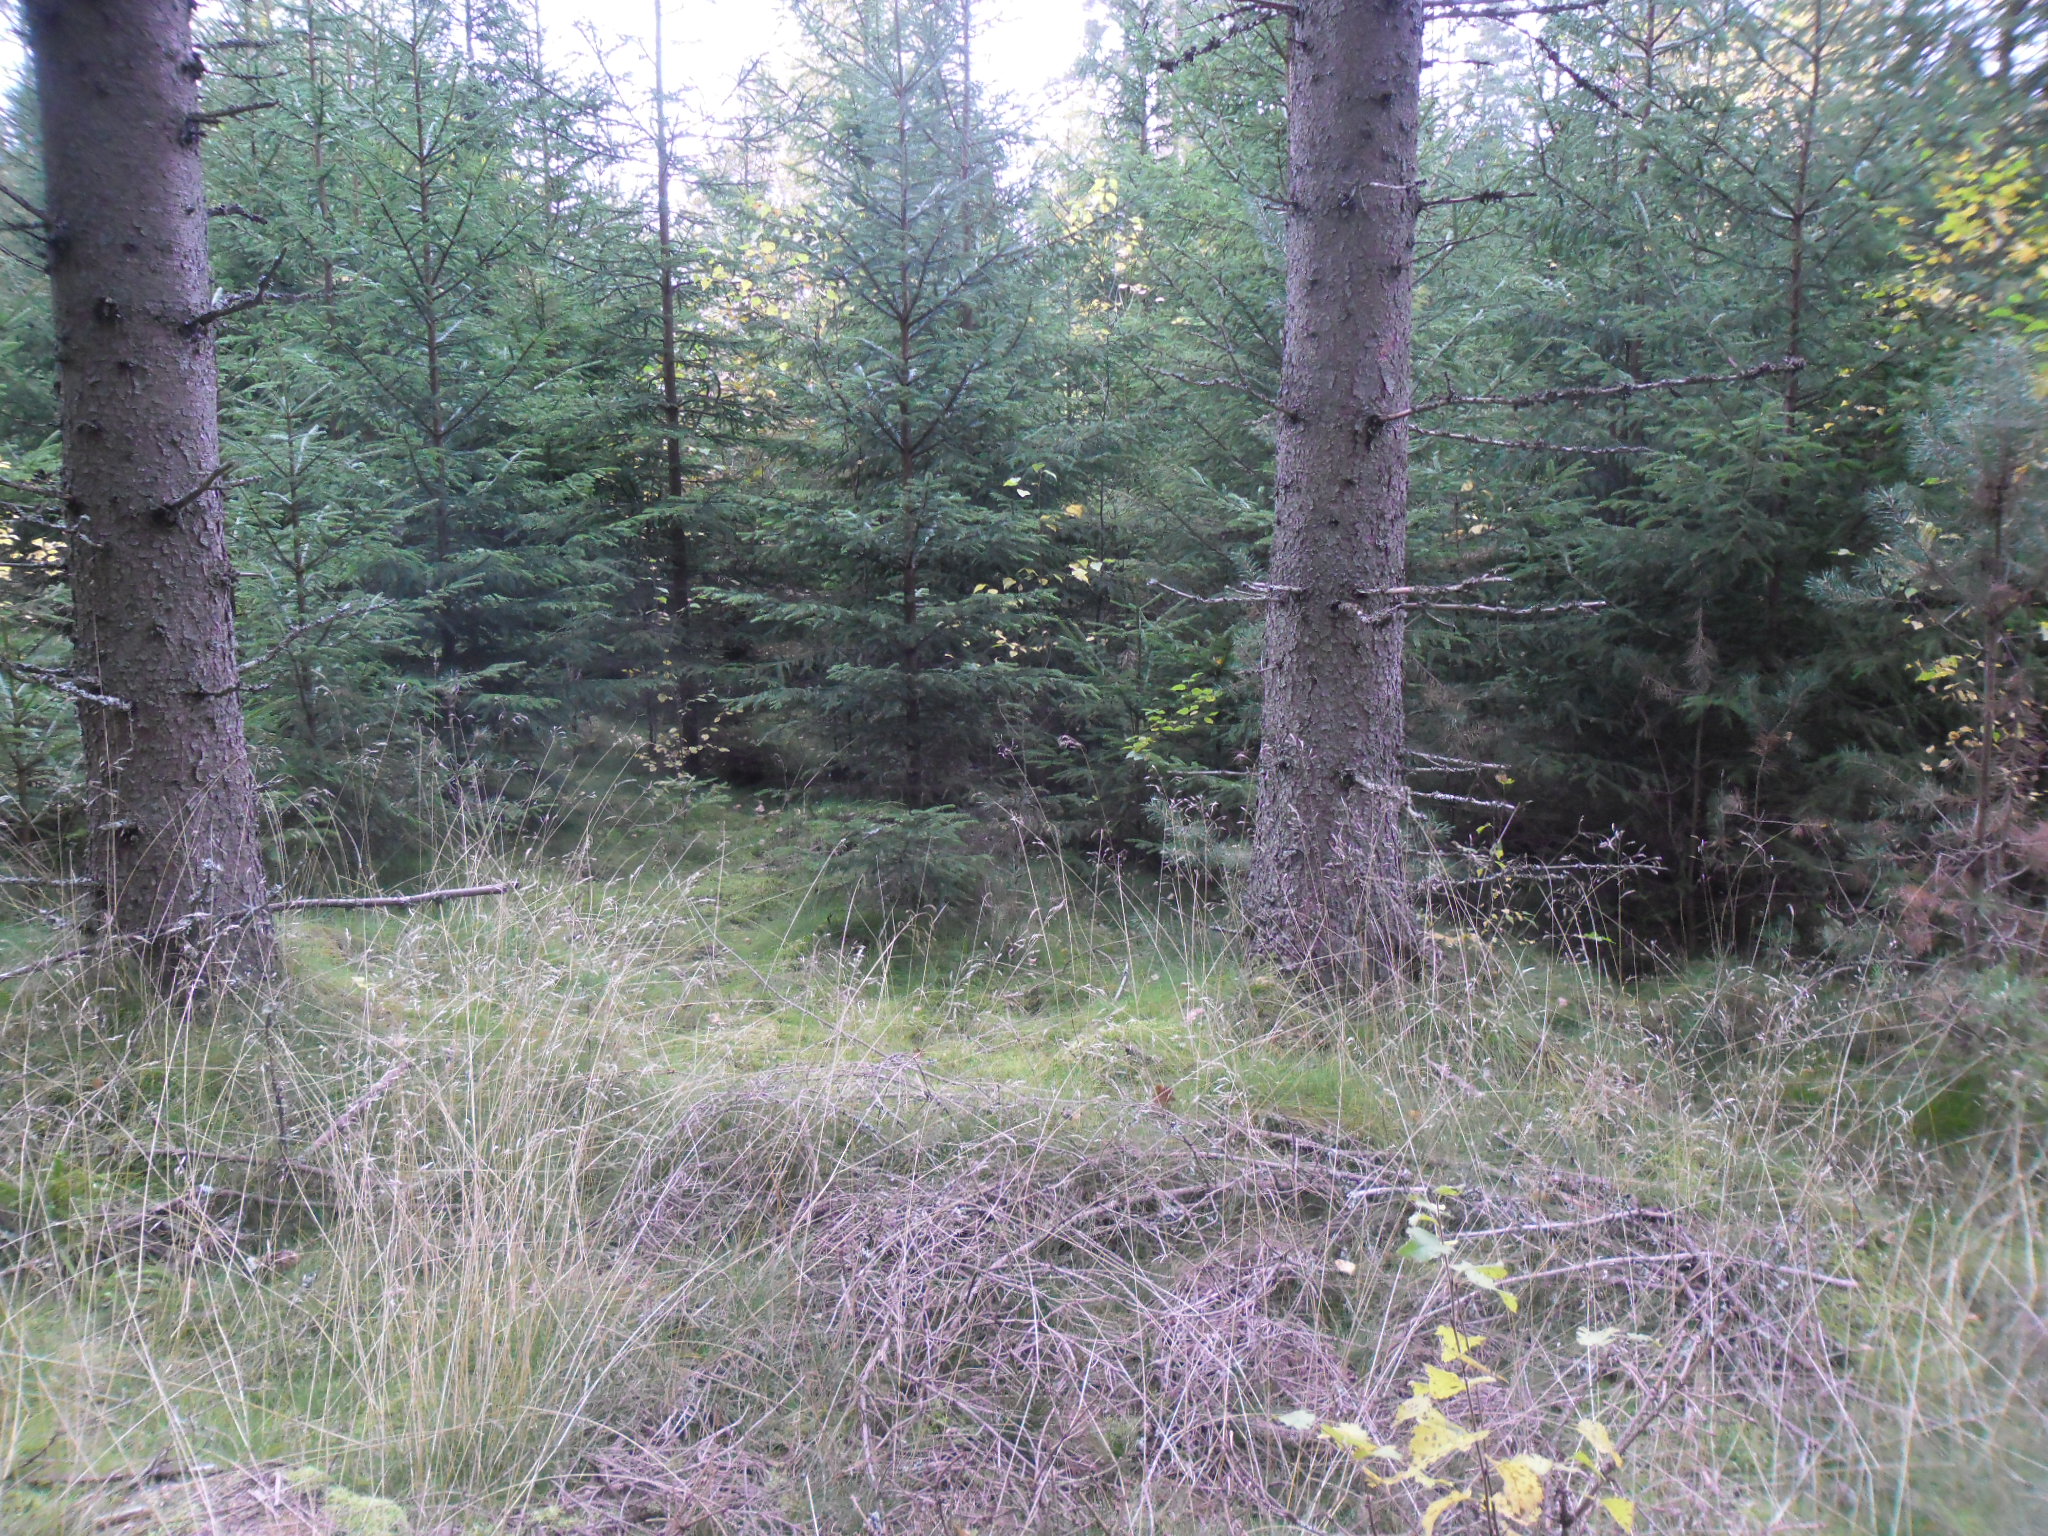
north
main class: Woodland
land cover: Spruce dominated coniferous woodland
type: boreal forest
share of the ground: > 75 %
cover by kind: coniferous forest trees 80 %, lichens and mosses 20 %
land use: Forestry
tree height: > 5 m
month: October
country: SE
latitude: 56.4125
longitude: 14.0331
